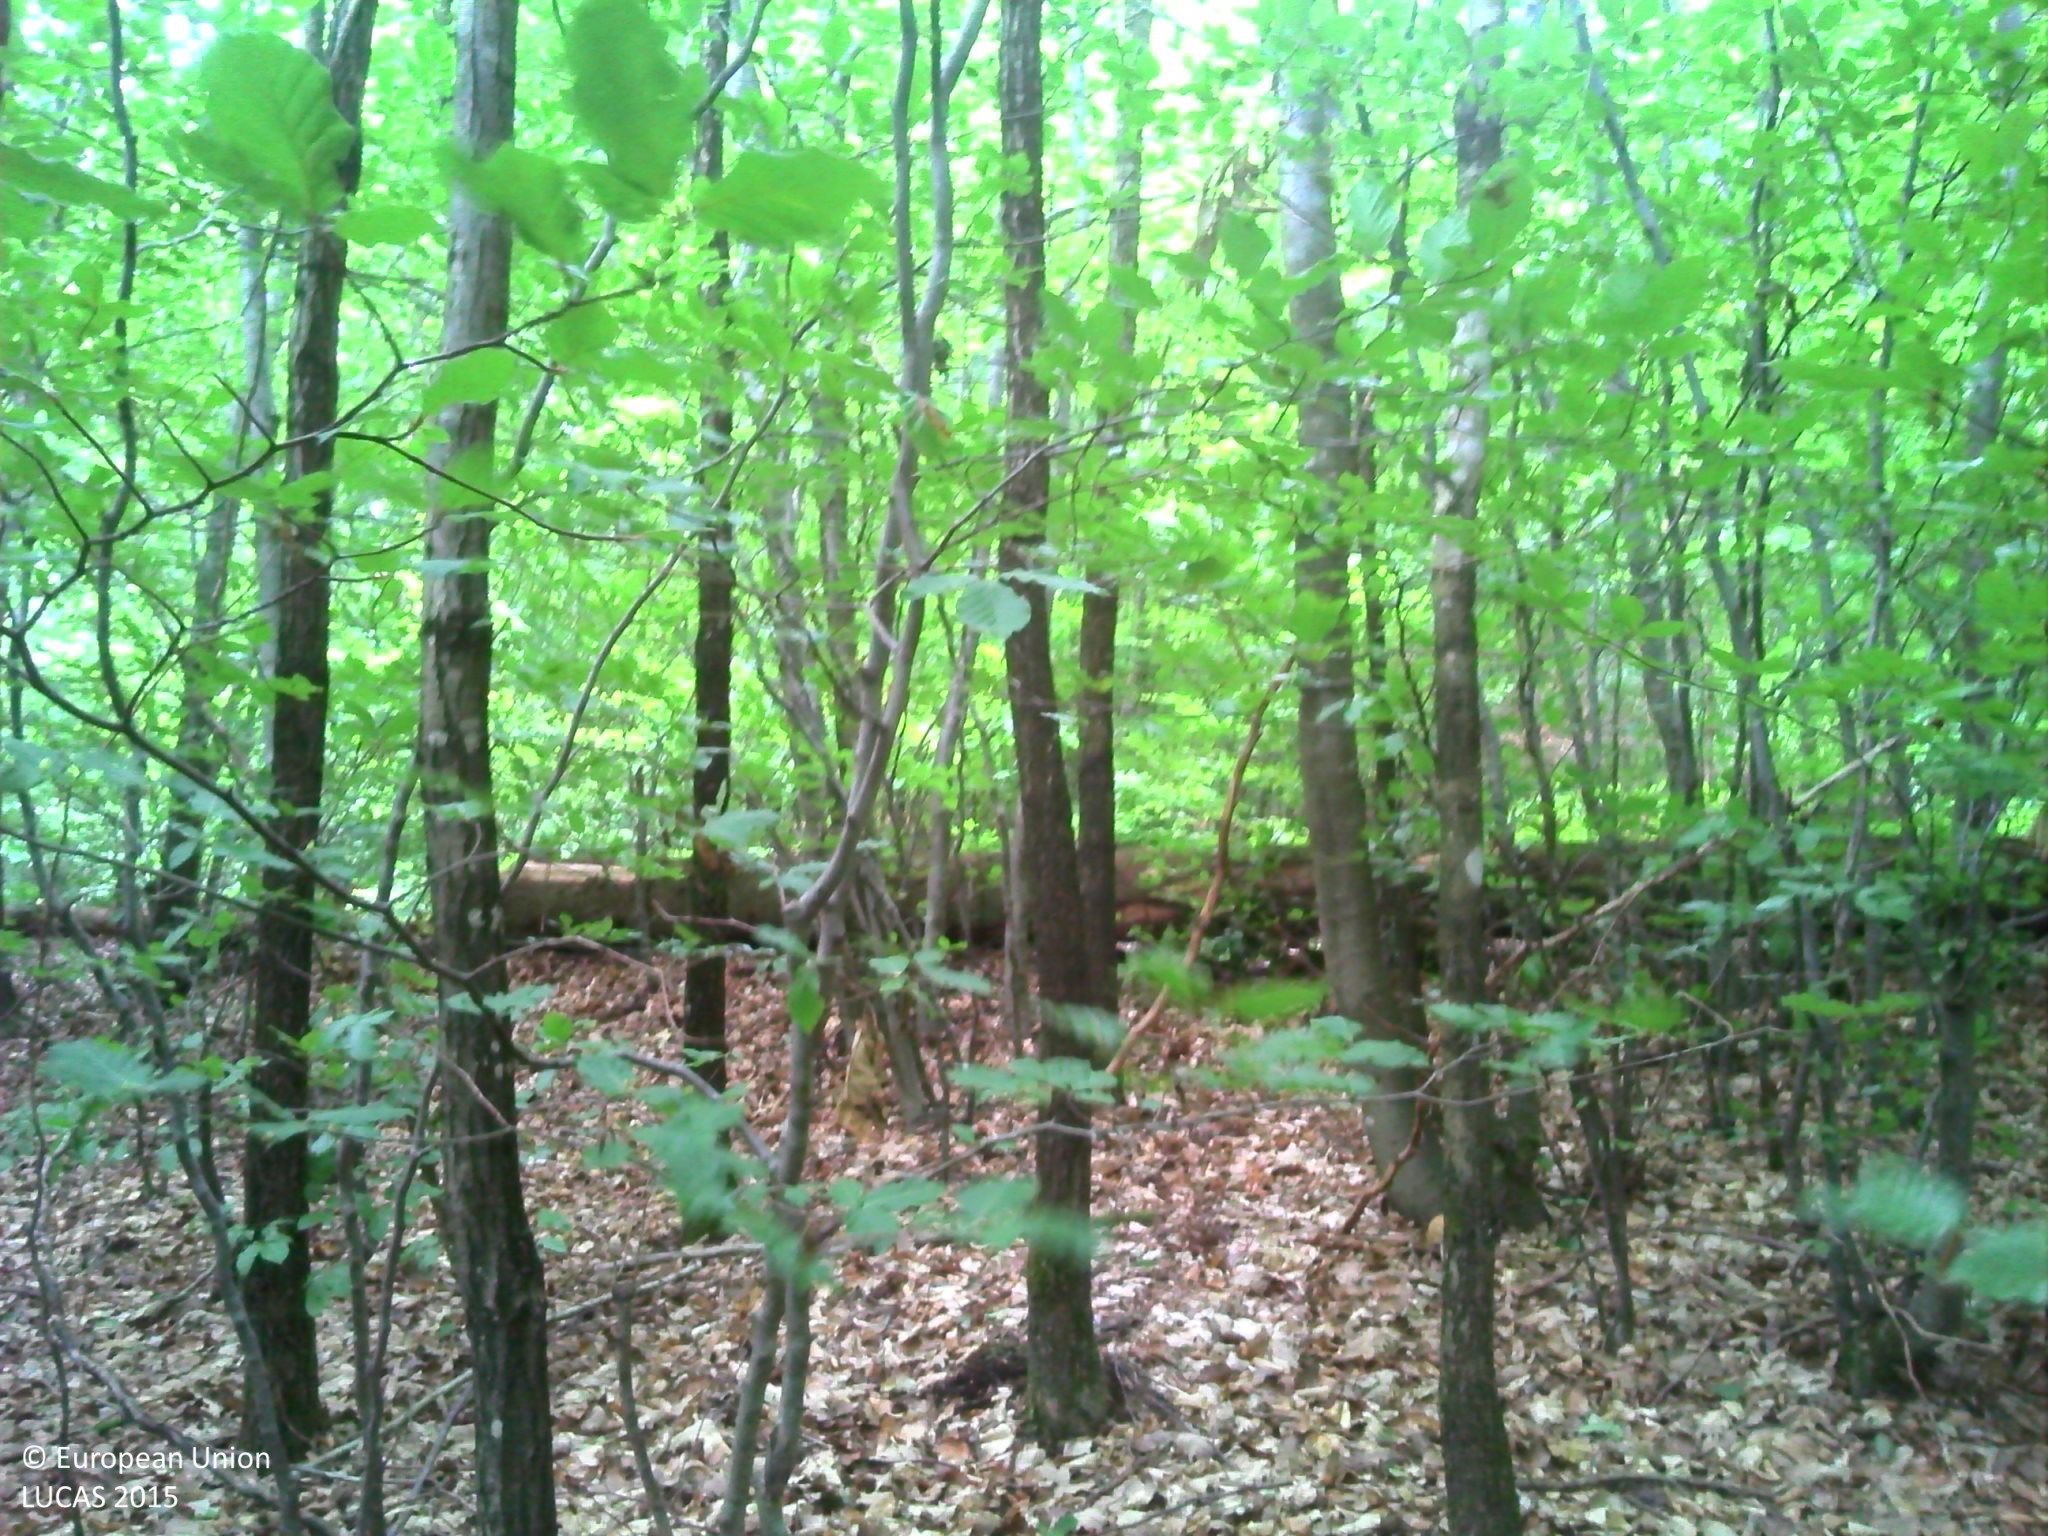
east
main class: Woodland
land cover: Broadleaved woodland
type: beech forest
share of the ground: > 75 %
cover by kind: broadleaved forest trees 100 %
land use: Forestry
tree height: > 5 m
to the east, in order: Broadleaved woodland; Paved roads, cycling and walking lanes; Broadleaved woodland; Tracks; Broadleaved woodland; Ditches and canals; Broadleaved woodland; Pine dominated mixed woodland; Tracks; Pine dominated mixed woodland
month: July
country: FR
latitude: 48.9339
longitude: 7.5298
